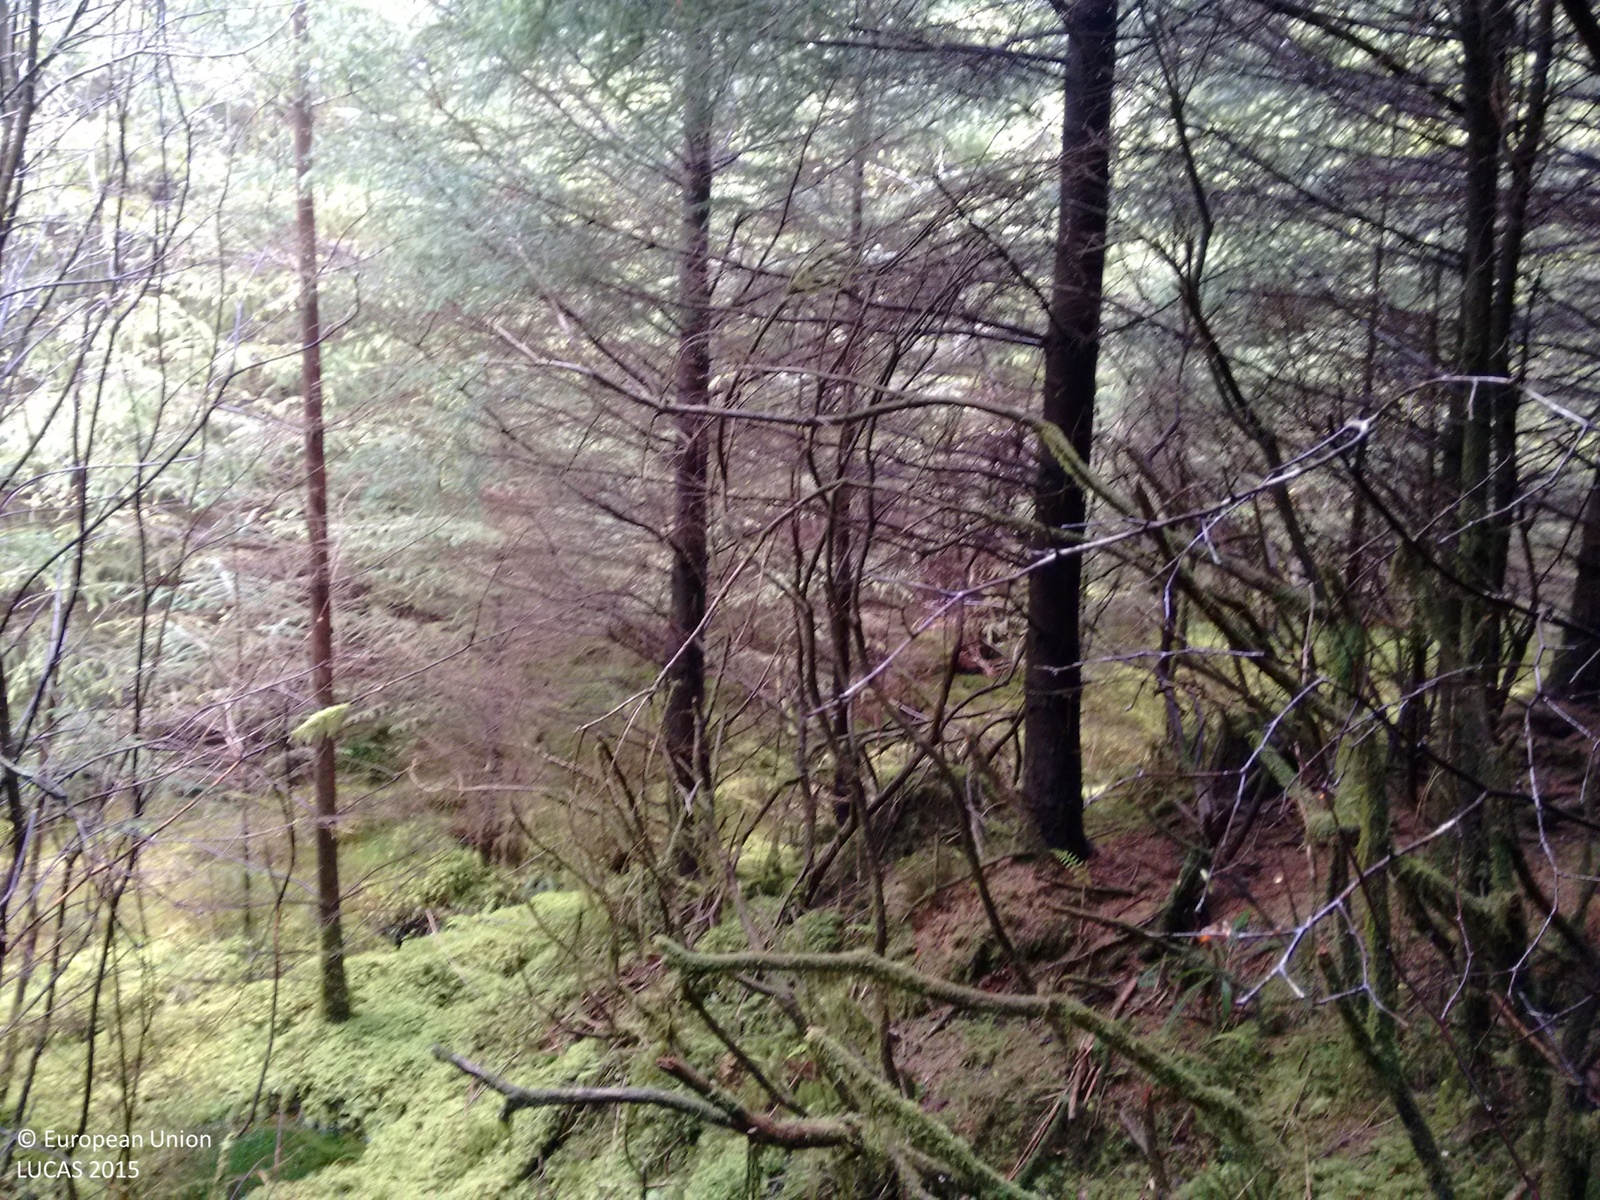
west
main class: Woodland
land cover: Spruce dominated coniferous woodland
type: exotic forest
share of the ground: > 75 %
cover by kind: coniferous forest trees 100 %
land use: Forestry
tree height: > 5 m
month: June
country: GB
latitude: 56.0369
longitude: -5.4157
